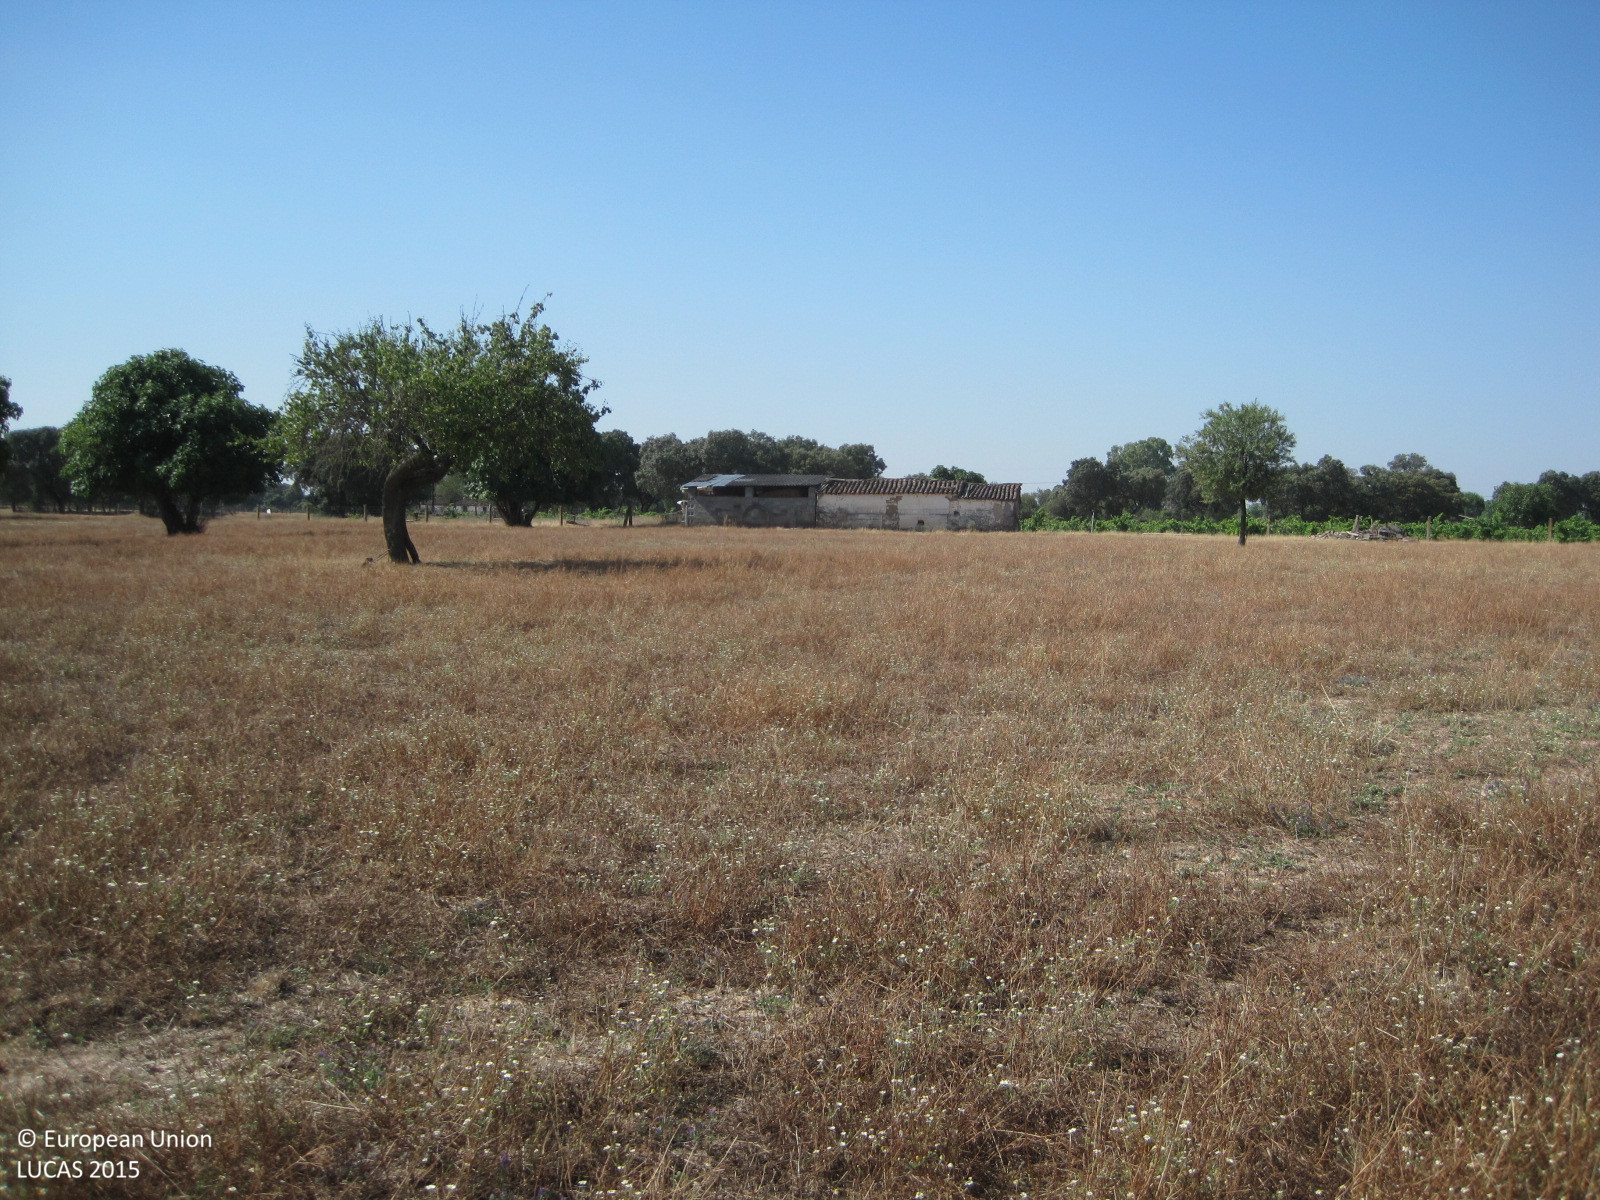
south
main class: Grassland
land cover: Grassland without tree/shrub cover
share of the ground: > 75 %
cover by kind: herbaceous plants 100 %
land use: Agriculture (excluding fallow land and kitchen gardens)
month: July
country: ES
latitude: 39.9836
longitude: -5.1482
